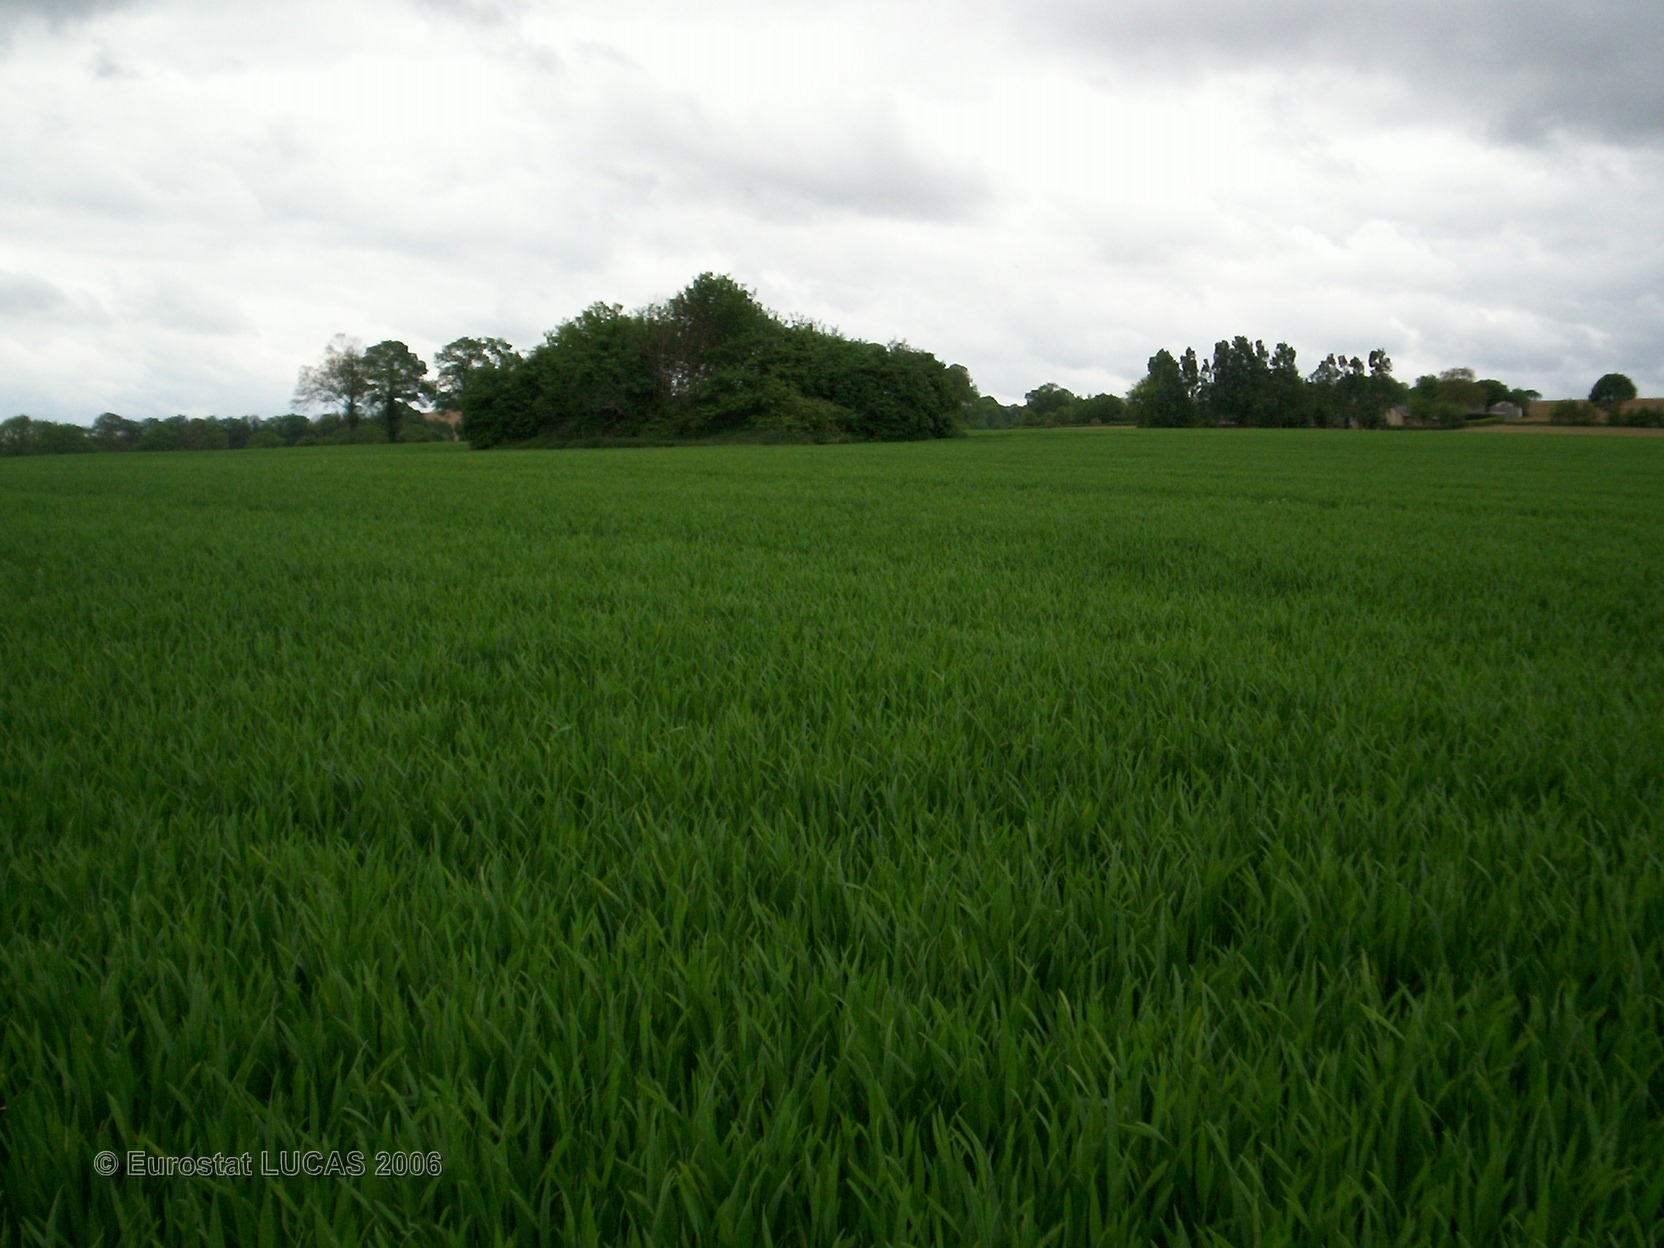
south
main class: Cropland
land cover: Common wheat
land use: Agriculture (excluding fallow land and kitchen gardens)
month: May
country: FR
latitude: 48.2878
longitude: -1.1882
